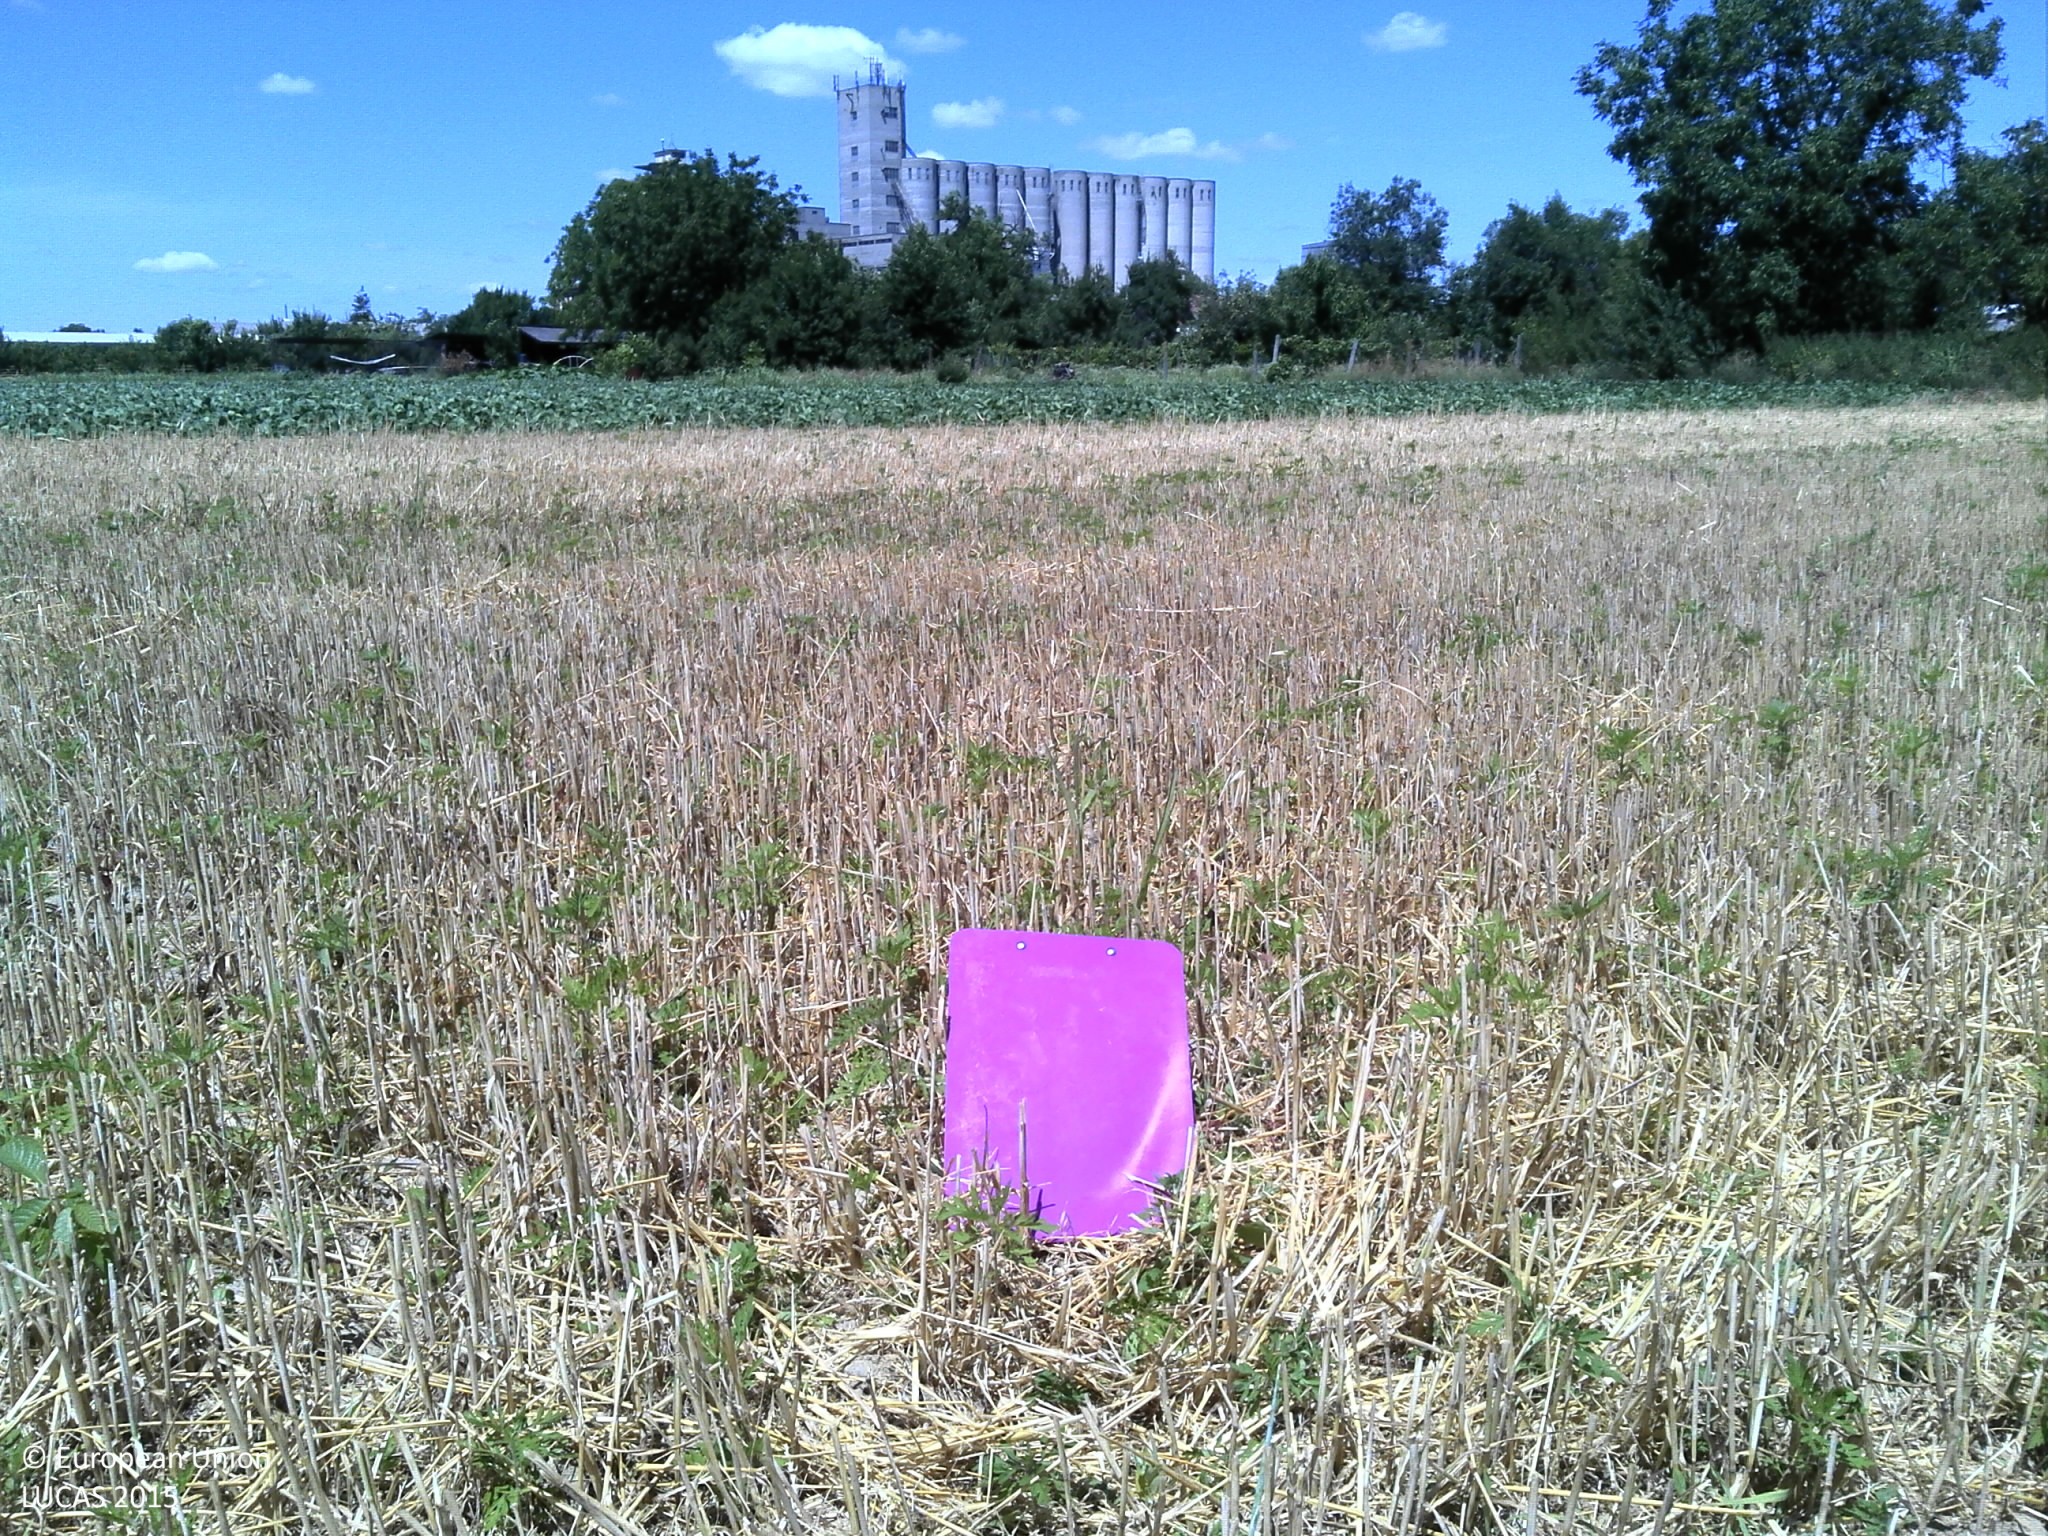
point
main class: Cropland
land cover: Barley
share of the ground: < 10 %
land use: Agriculture (excluding fallow land and kitchen gardens)
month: June
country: HR
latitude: 45.7488
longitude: 18.1681
